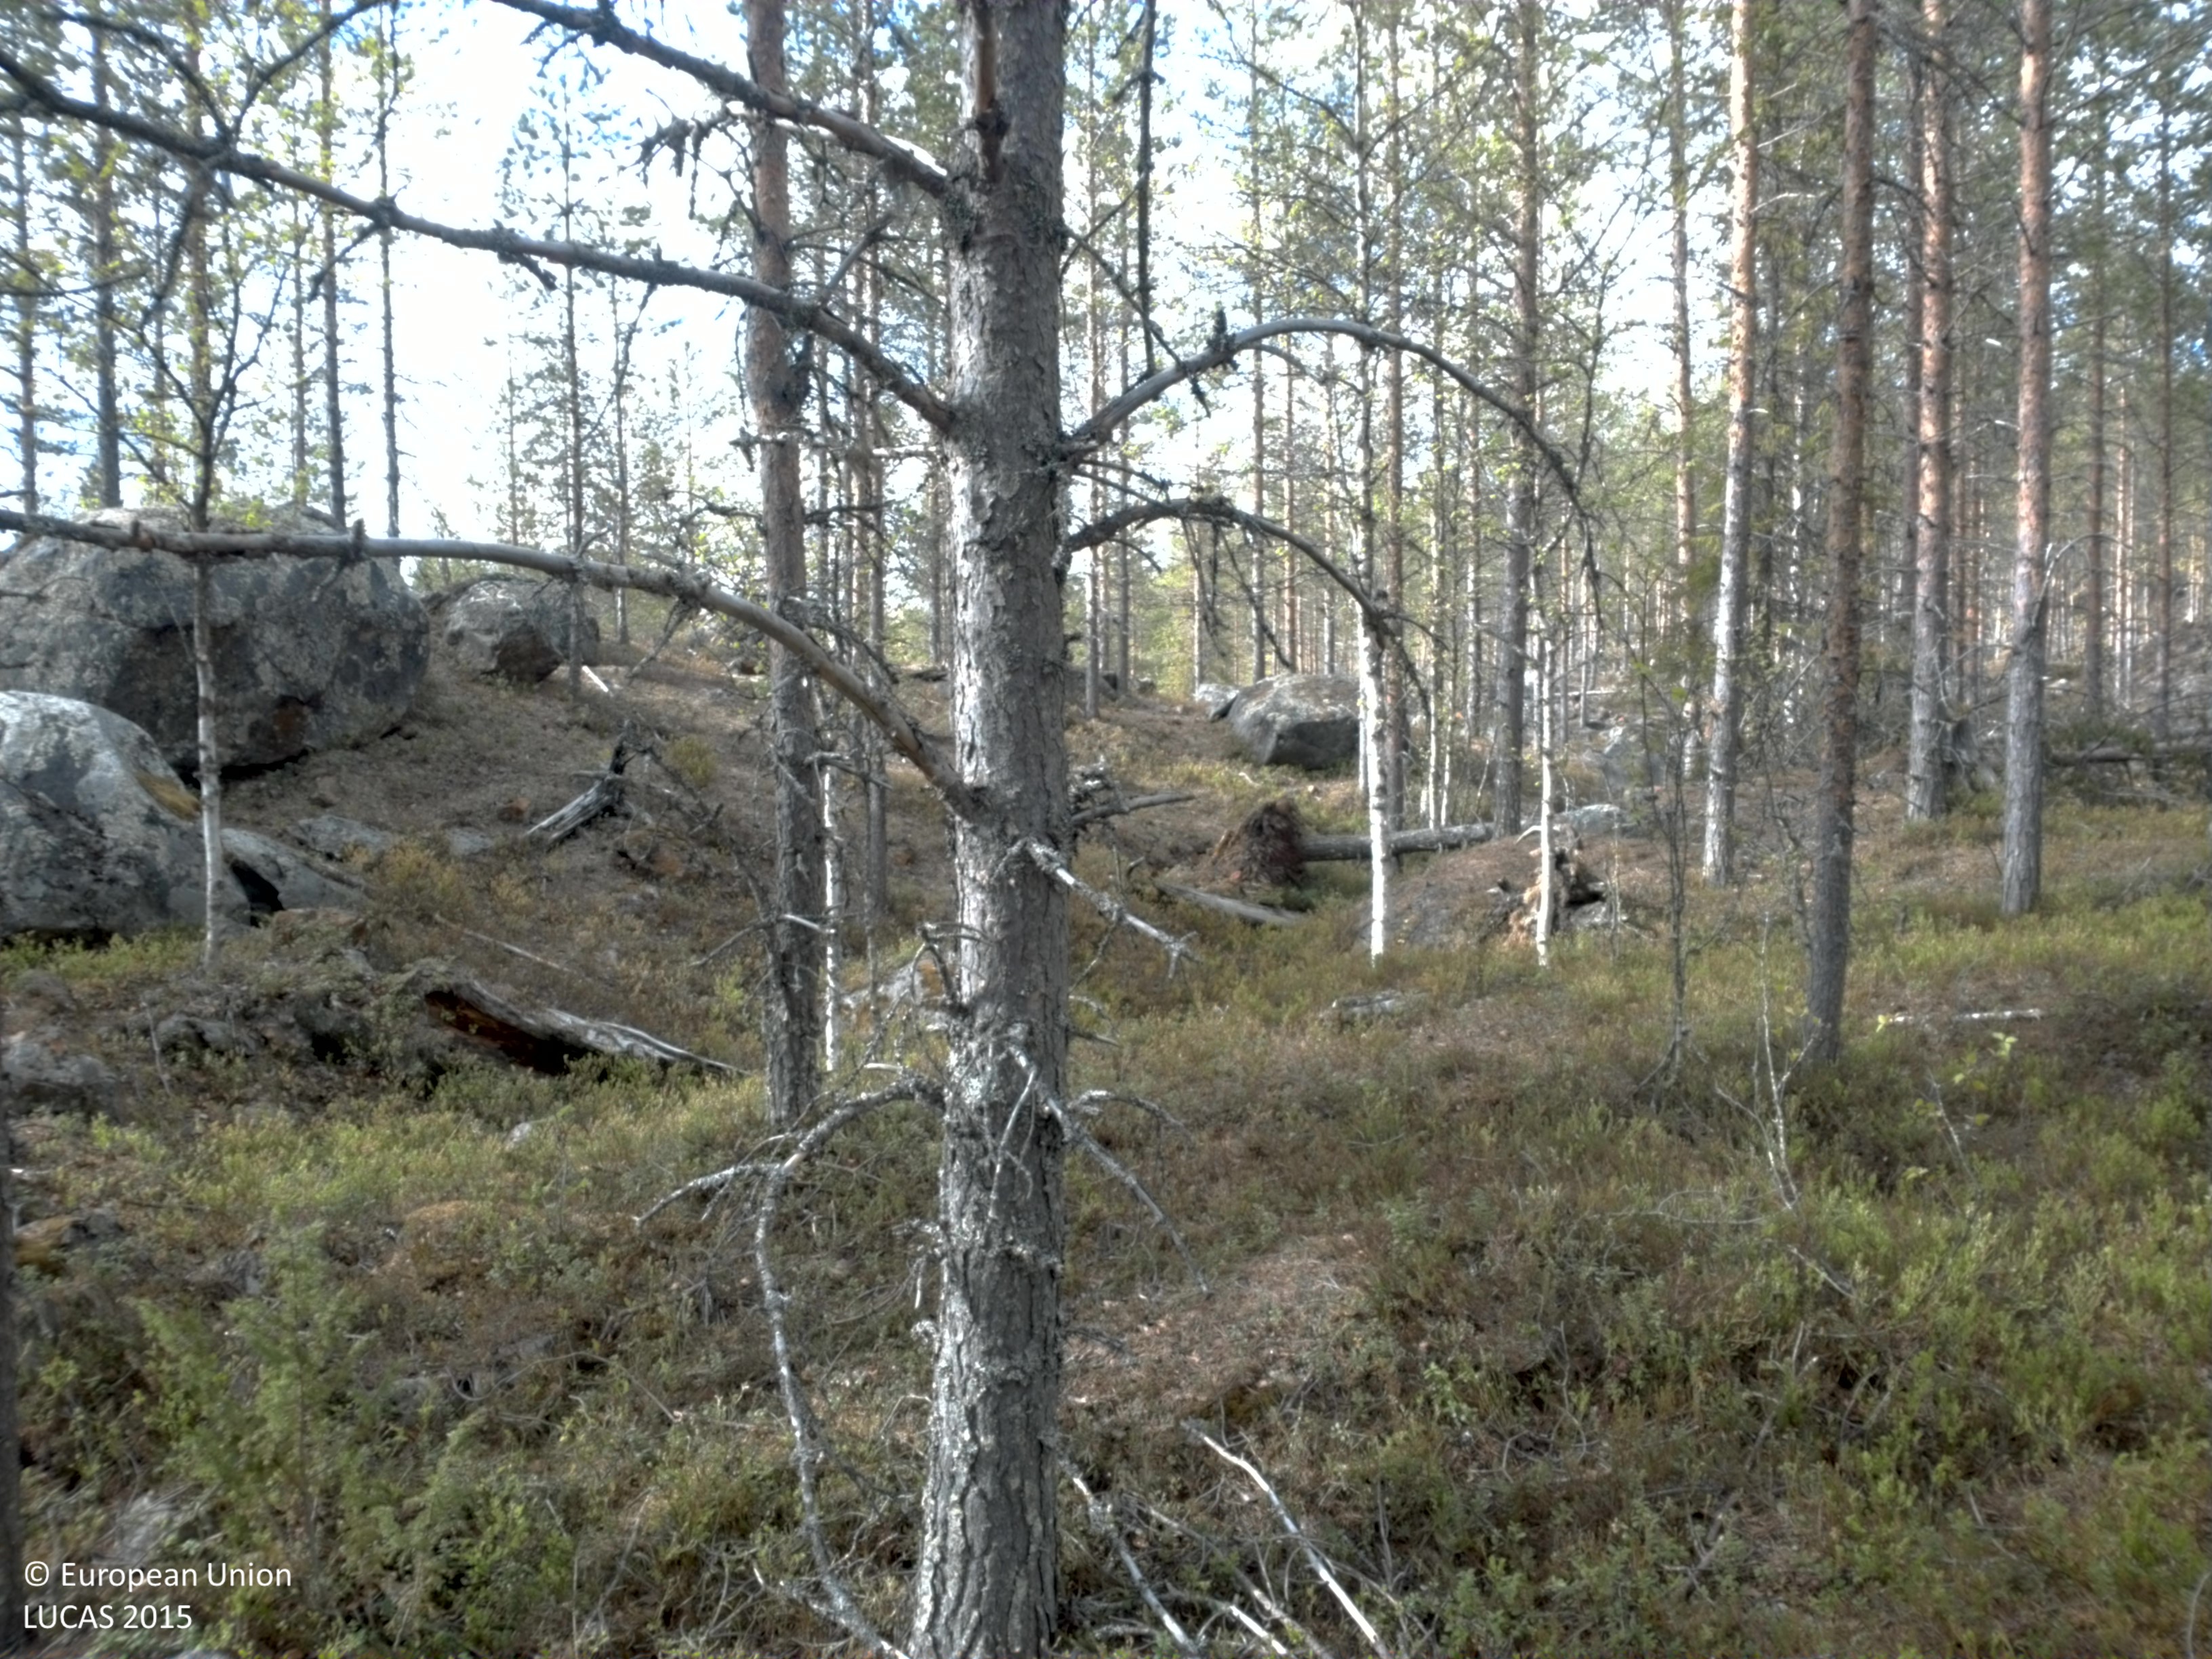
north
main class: Woodland
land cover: Pine dominated coniferous woodland
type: boreal forest
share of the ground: 25 - 50 %
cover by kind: shrubs 35 %, coniferous forest trees 30 %, unconsolidated bare surface 15 %, lichens and mosses 10 %, broadleaved forest trees 5 %, herbaceous plants 5 %
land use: Forestry
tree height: > 5 m
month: June
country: SE
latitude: 64.3607
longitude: 17.6114
